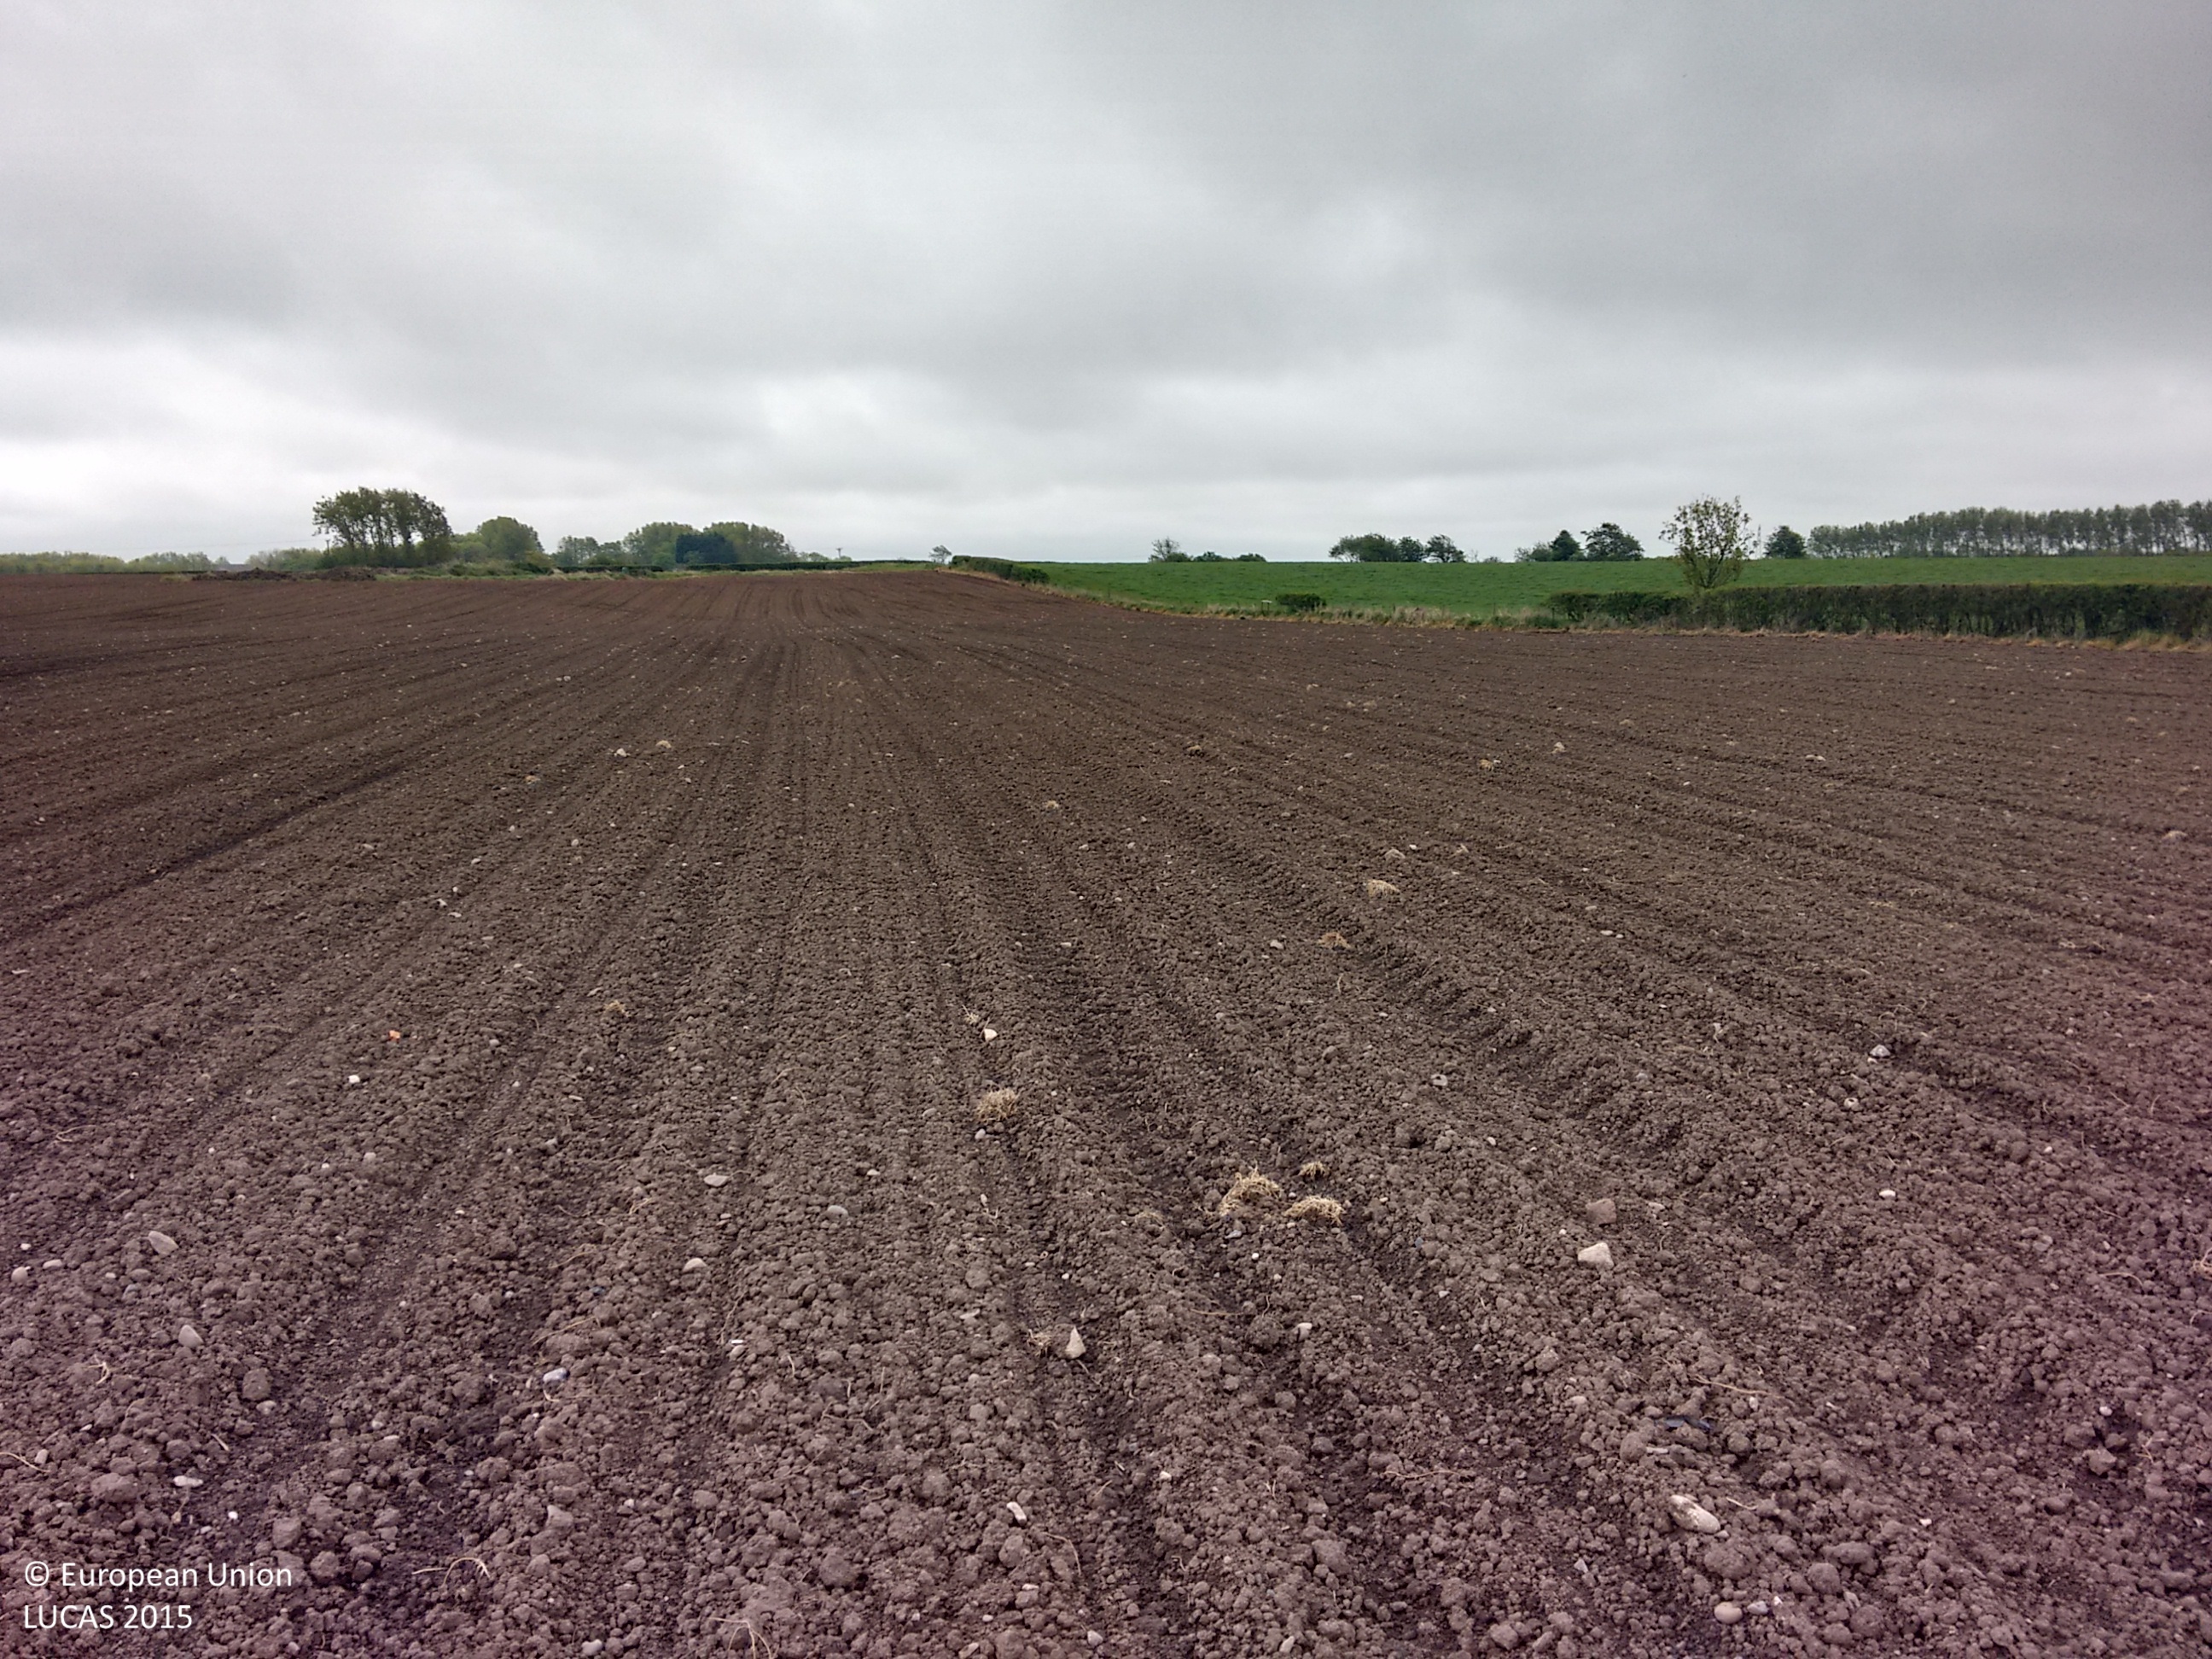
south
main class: Cropland
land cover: Maize
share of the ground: < 10 %
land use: Agriculture (excluding fallow land and kitchen gardens)
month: May
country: GB
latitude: 53.7660
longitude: -2.8910
